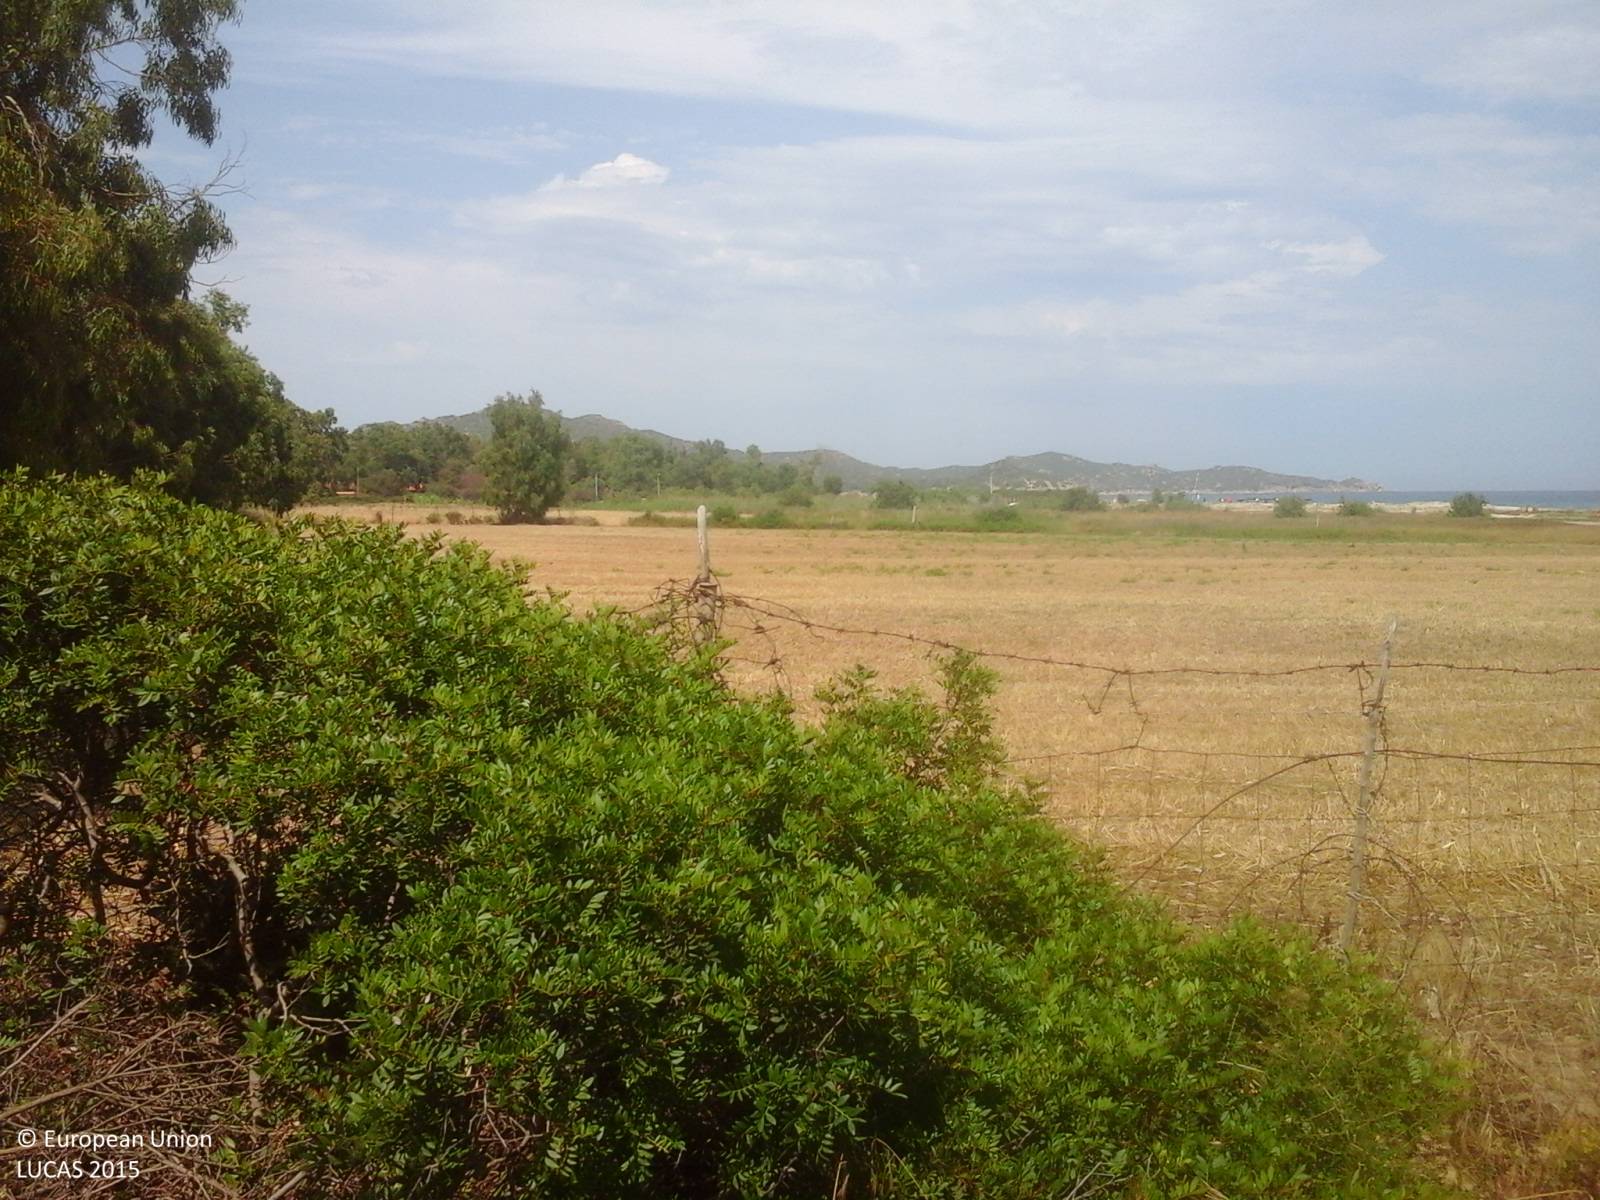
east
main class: Cropland
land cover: Common wheat
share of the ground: > 75 %
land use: Agriculture (excluding fallow land and kitchen gardens)
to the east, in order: Common wheat; Fences; Abandoned hedges; Tracks; Grassland without tree/shrub cover; Fences; Salt marshes; Fences; Sand
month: June
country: IT
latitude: 39.2885
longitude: 9.5967
